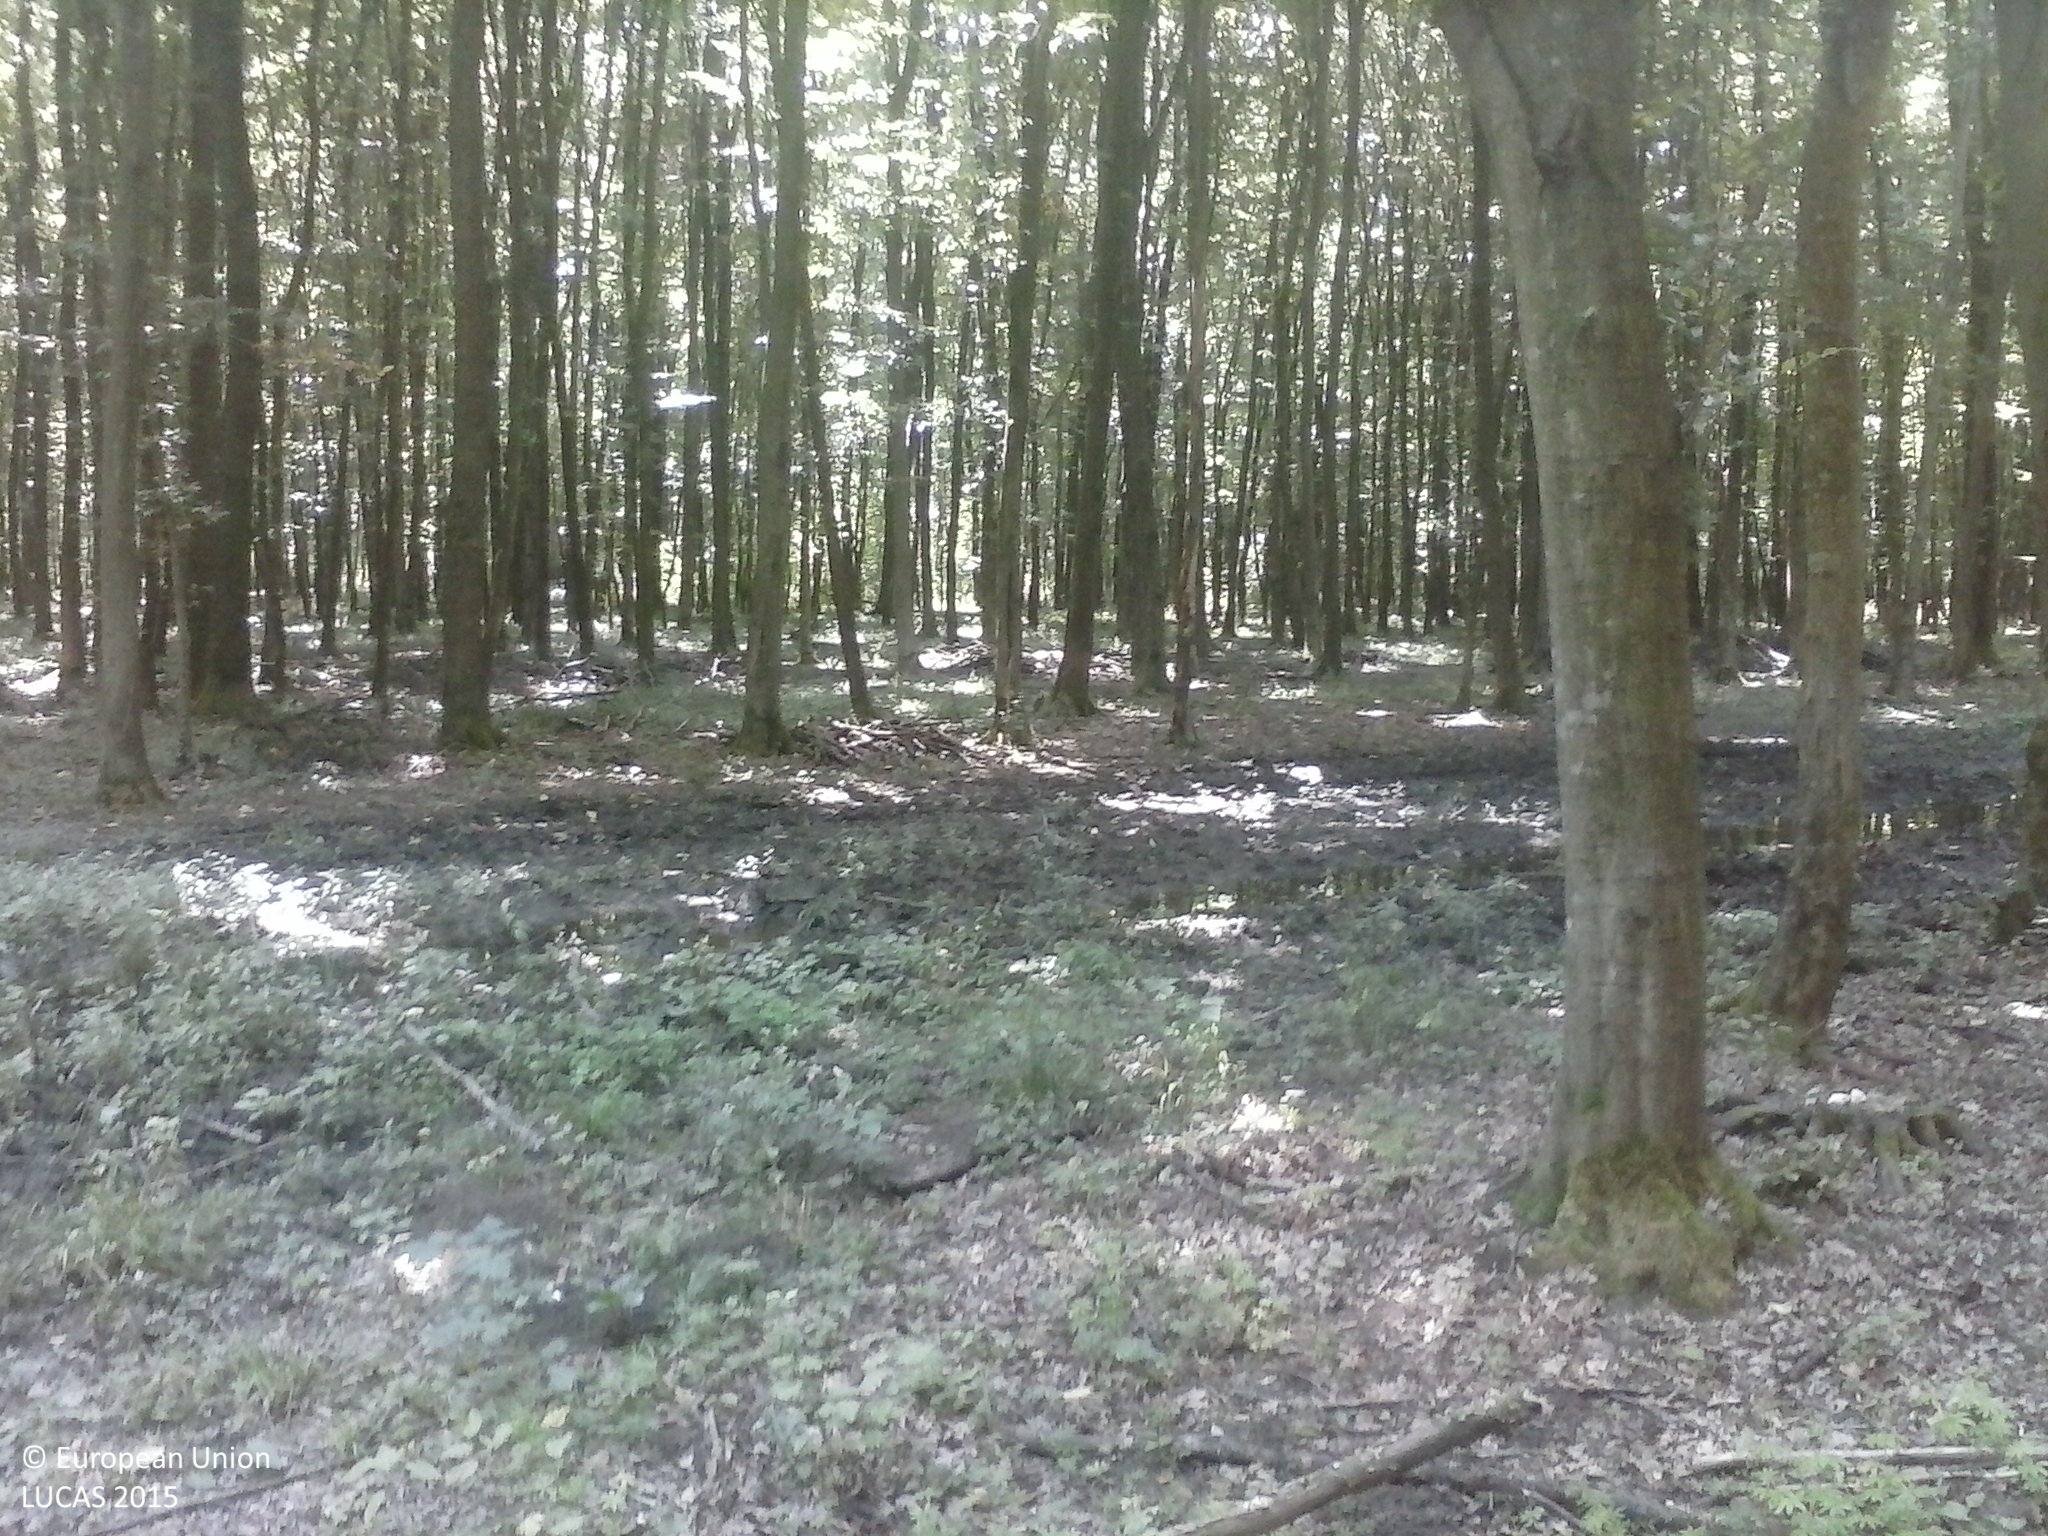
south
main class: Woodland
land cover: Broadleaved woodland
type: mesophytic deciduous forest
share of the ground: > 75 %
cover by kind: broadleaved forest trees 90 %, shrubs 5 %, consolidated bare surface 5 %
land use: Forestry
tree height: > 5 m
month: August
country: HU
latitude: 45.8747
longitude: 17.6951
